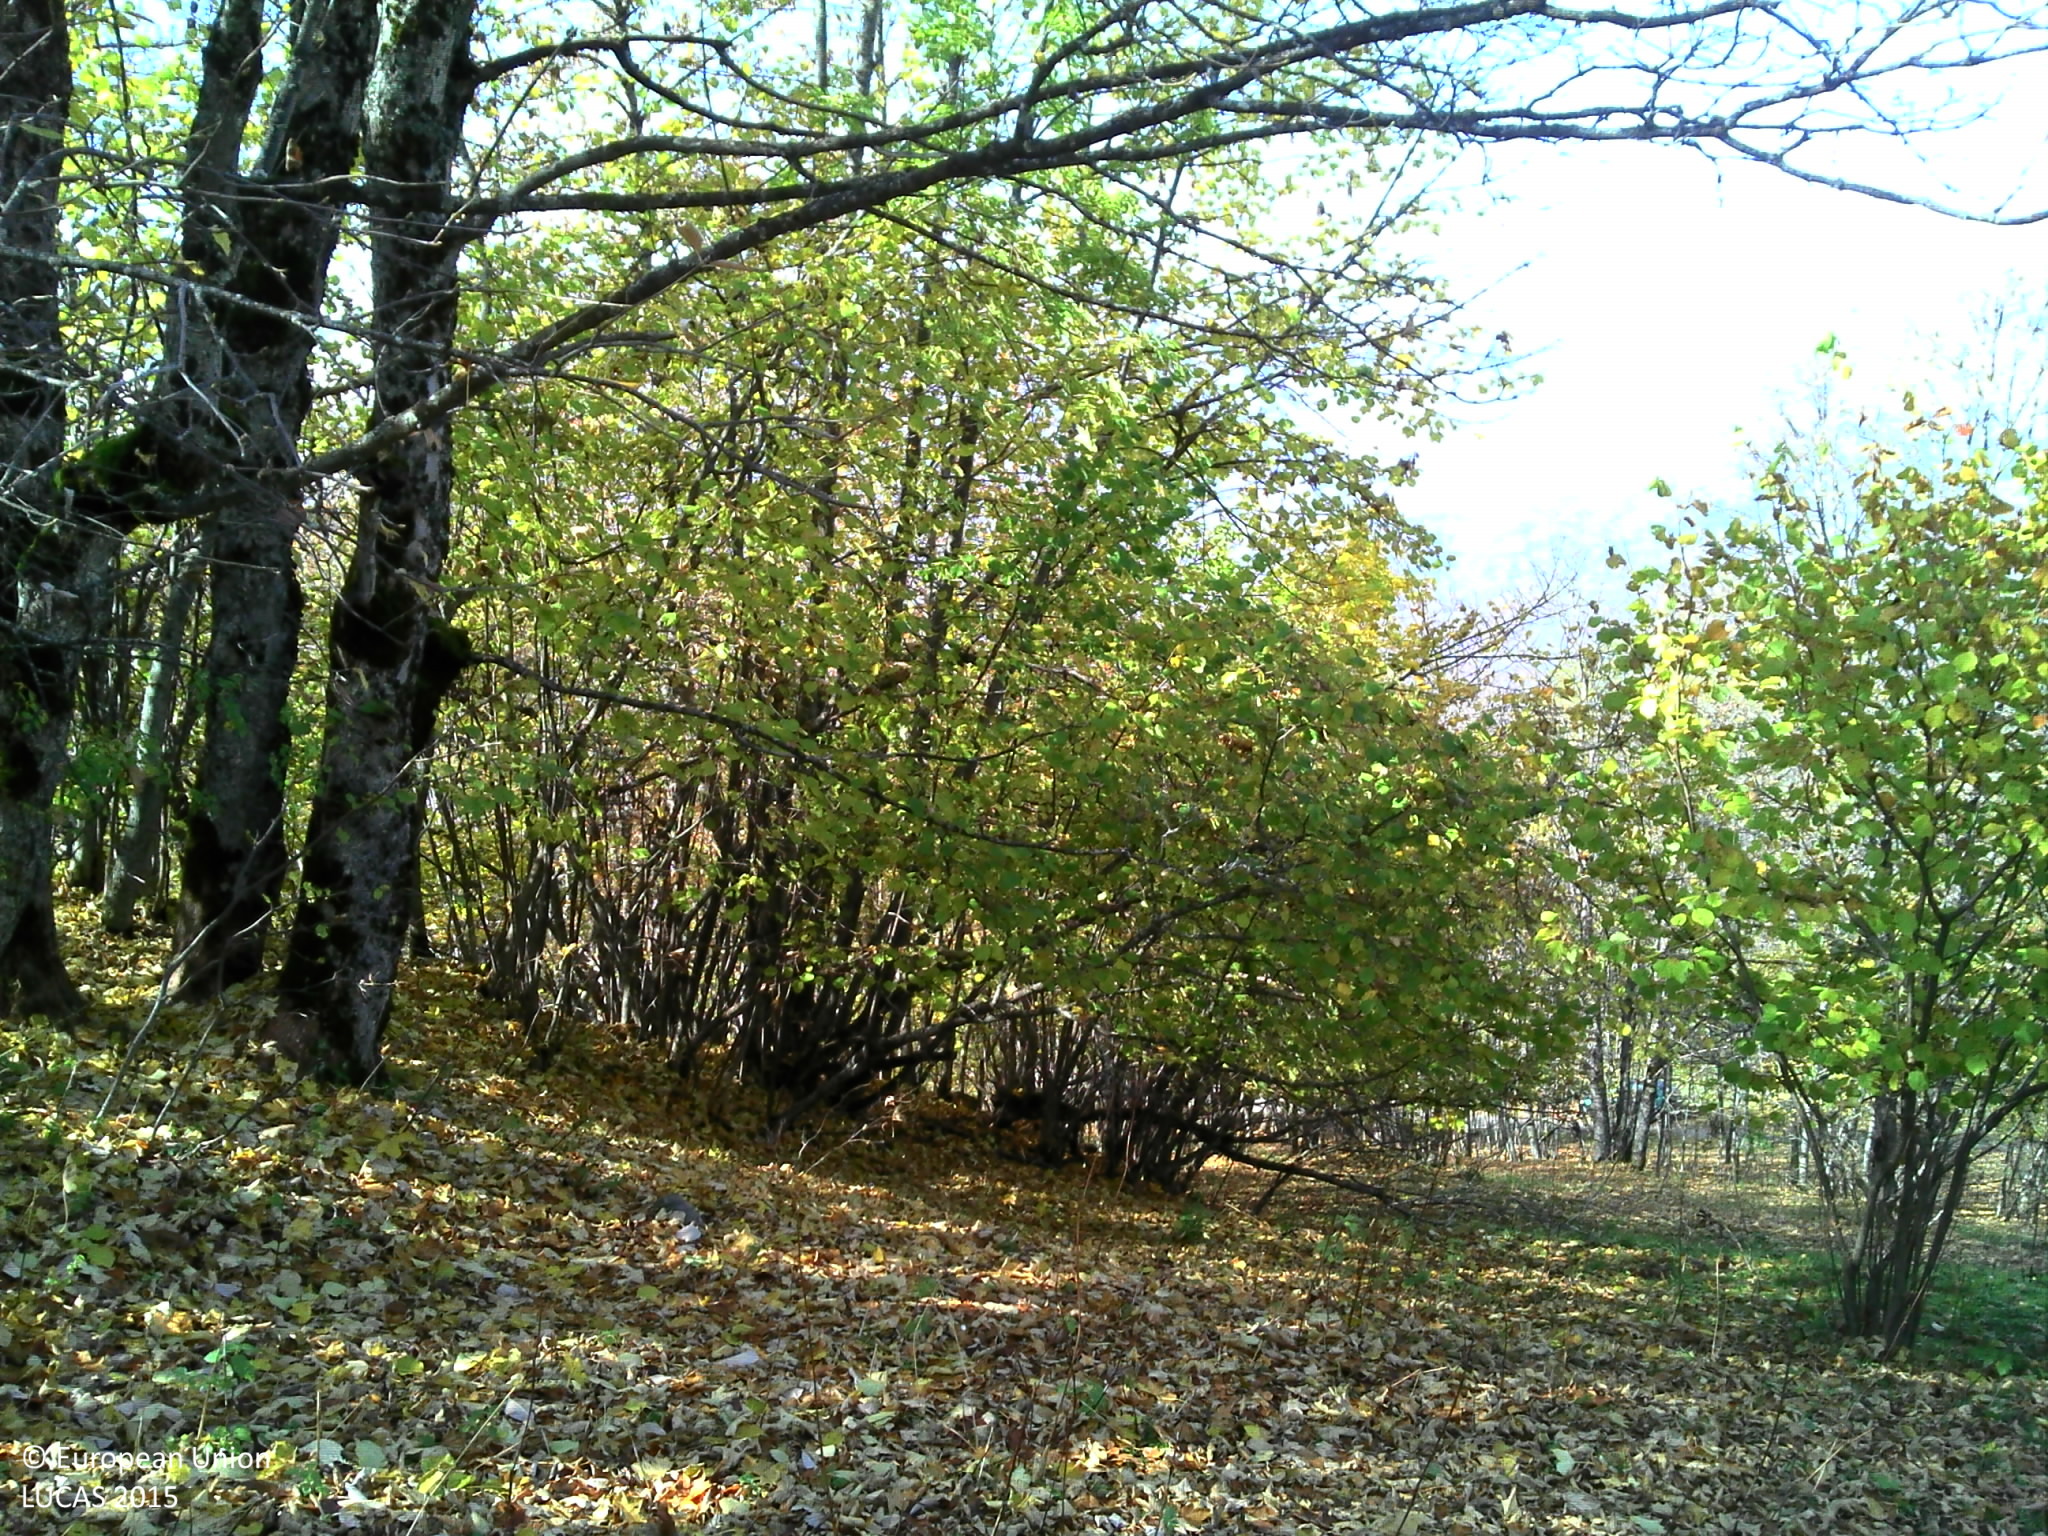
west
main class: Woodland
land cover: Broadleaved woodland
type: mesophytic deciduous forest
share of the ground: 25 - 50 %
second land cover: Grassland without tree/shrub cover
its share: > 75 %
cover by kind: herbaceous plants 70 %, broadleaved forest trees 30 %
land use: Forestry
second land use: Agriculture (excluding fallow land and kitchen gardens)
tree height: > 5 m
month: October
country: FR
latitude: 45.3697
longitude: 6.3659
